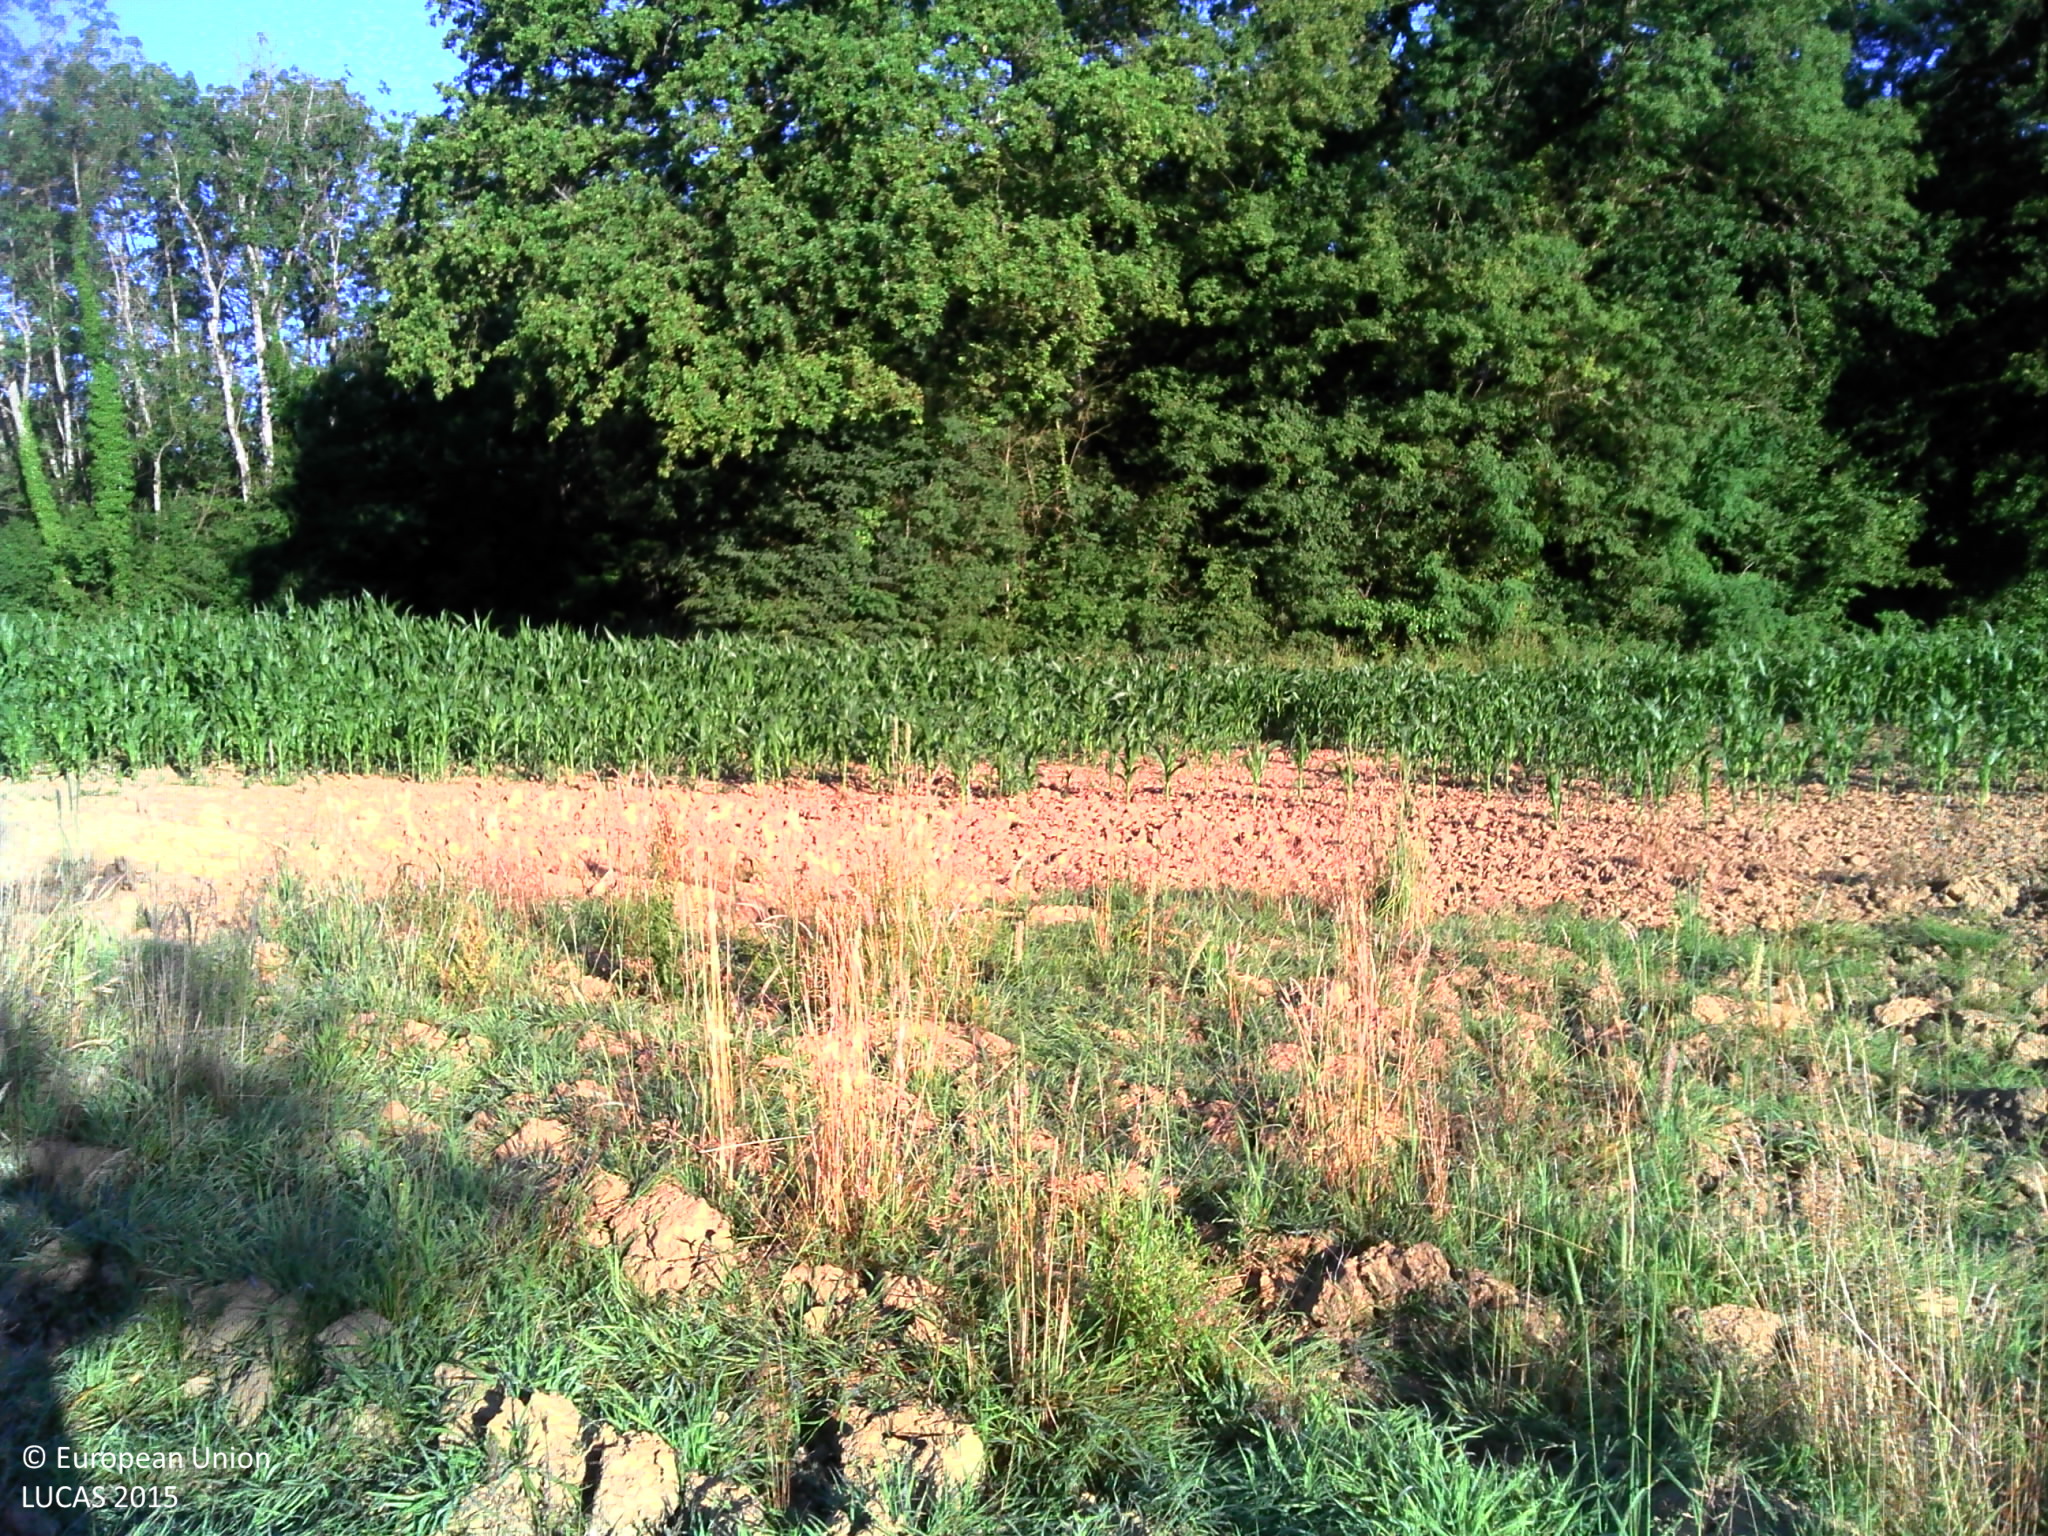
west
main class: Grassland
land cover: Grassland without tree/shrub cover
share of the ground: 50 - 75 %
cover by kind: herbaceous plants 95 %, consolidated bare surface 5 %
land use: Agriculture (excluding fallow land and kitchen gardens)
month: June
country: FR
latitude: 47.3777
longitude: 6.0414
